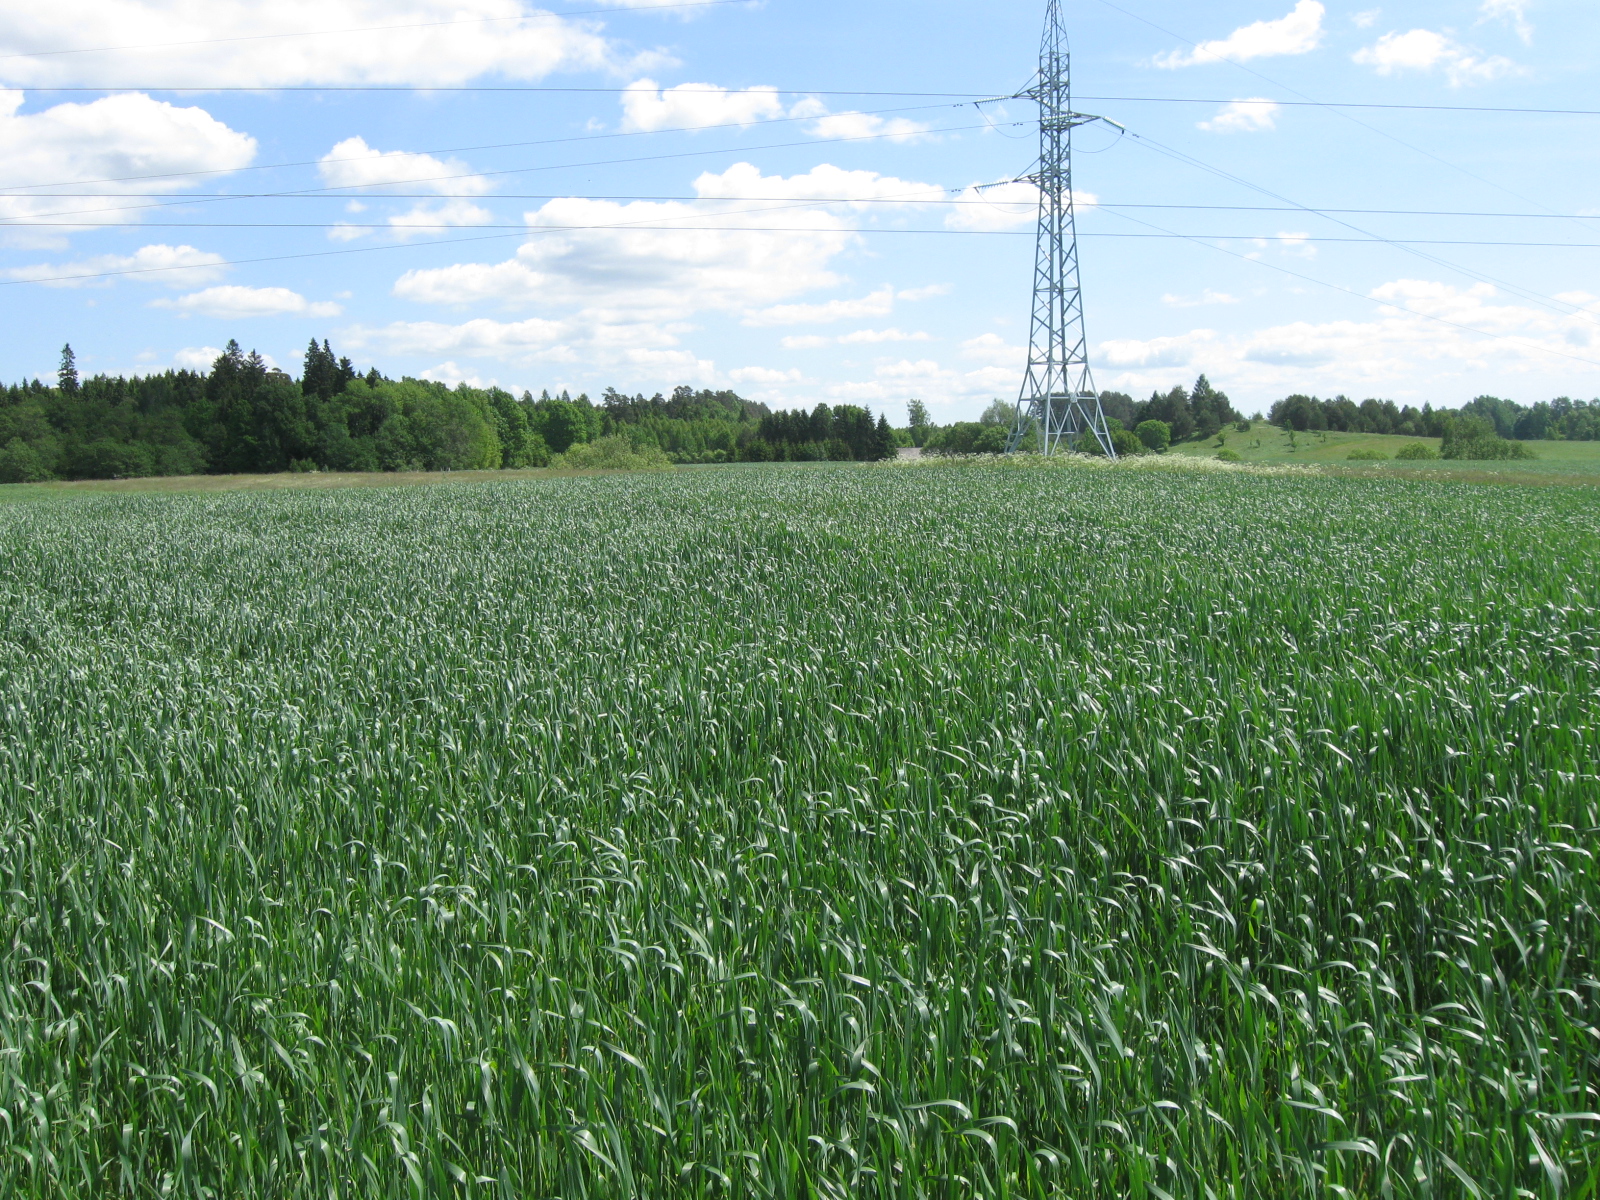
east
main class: Cropland
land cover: Common wheat
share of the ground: > 75 %
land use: Agriculture (excluding fallow land and kitchen gardens)
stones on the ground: < 10 %
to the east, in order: Common wheat; Electric lines; Common wheat; Grassland without tree/shrub cover; Electric lines; Grassland without tree/shrub cover; Single bushes/trees; Grassland without tree/shrub cover; Common wheat
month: June
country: LT
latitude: 54.5916
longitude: 23.8469
